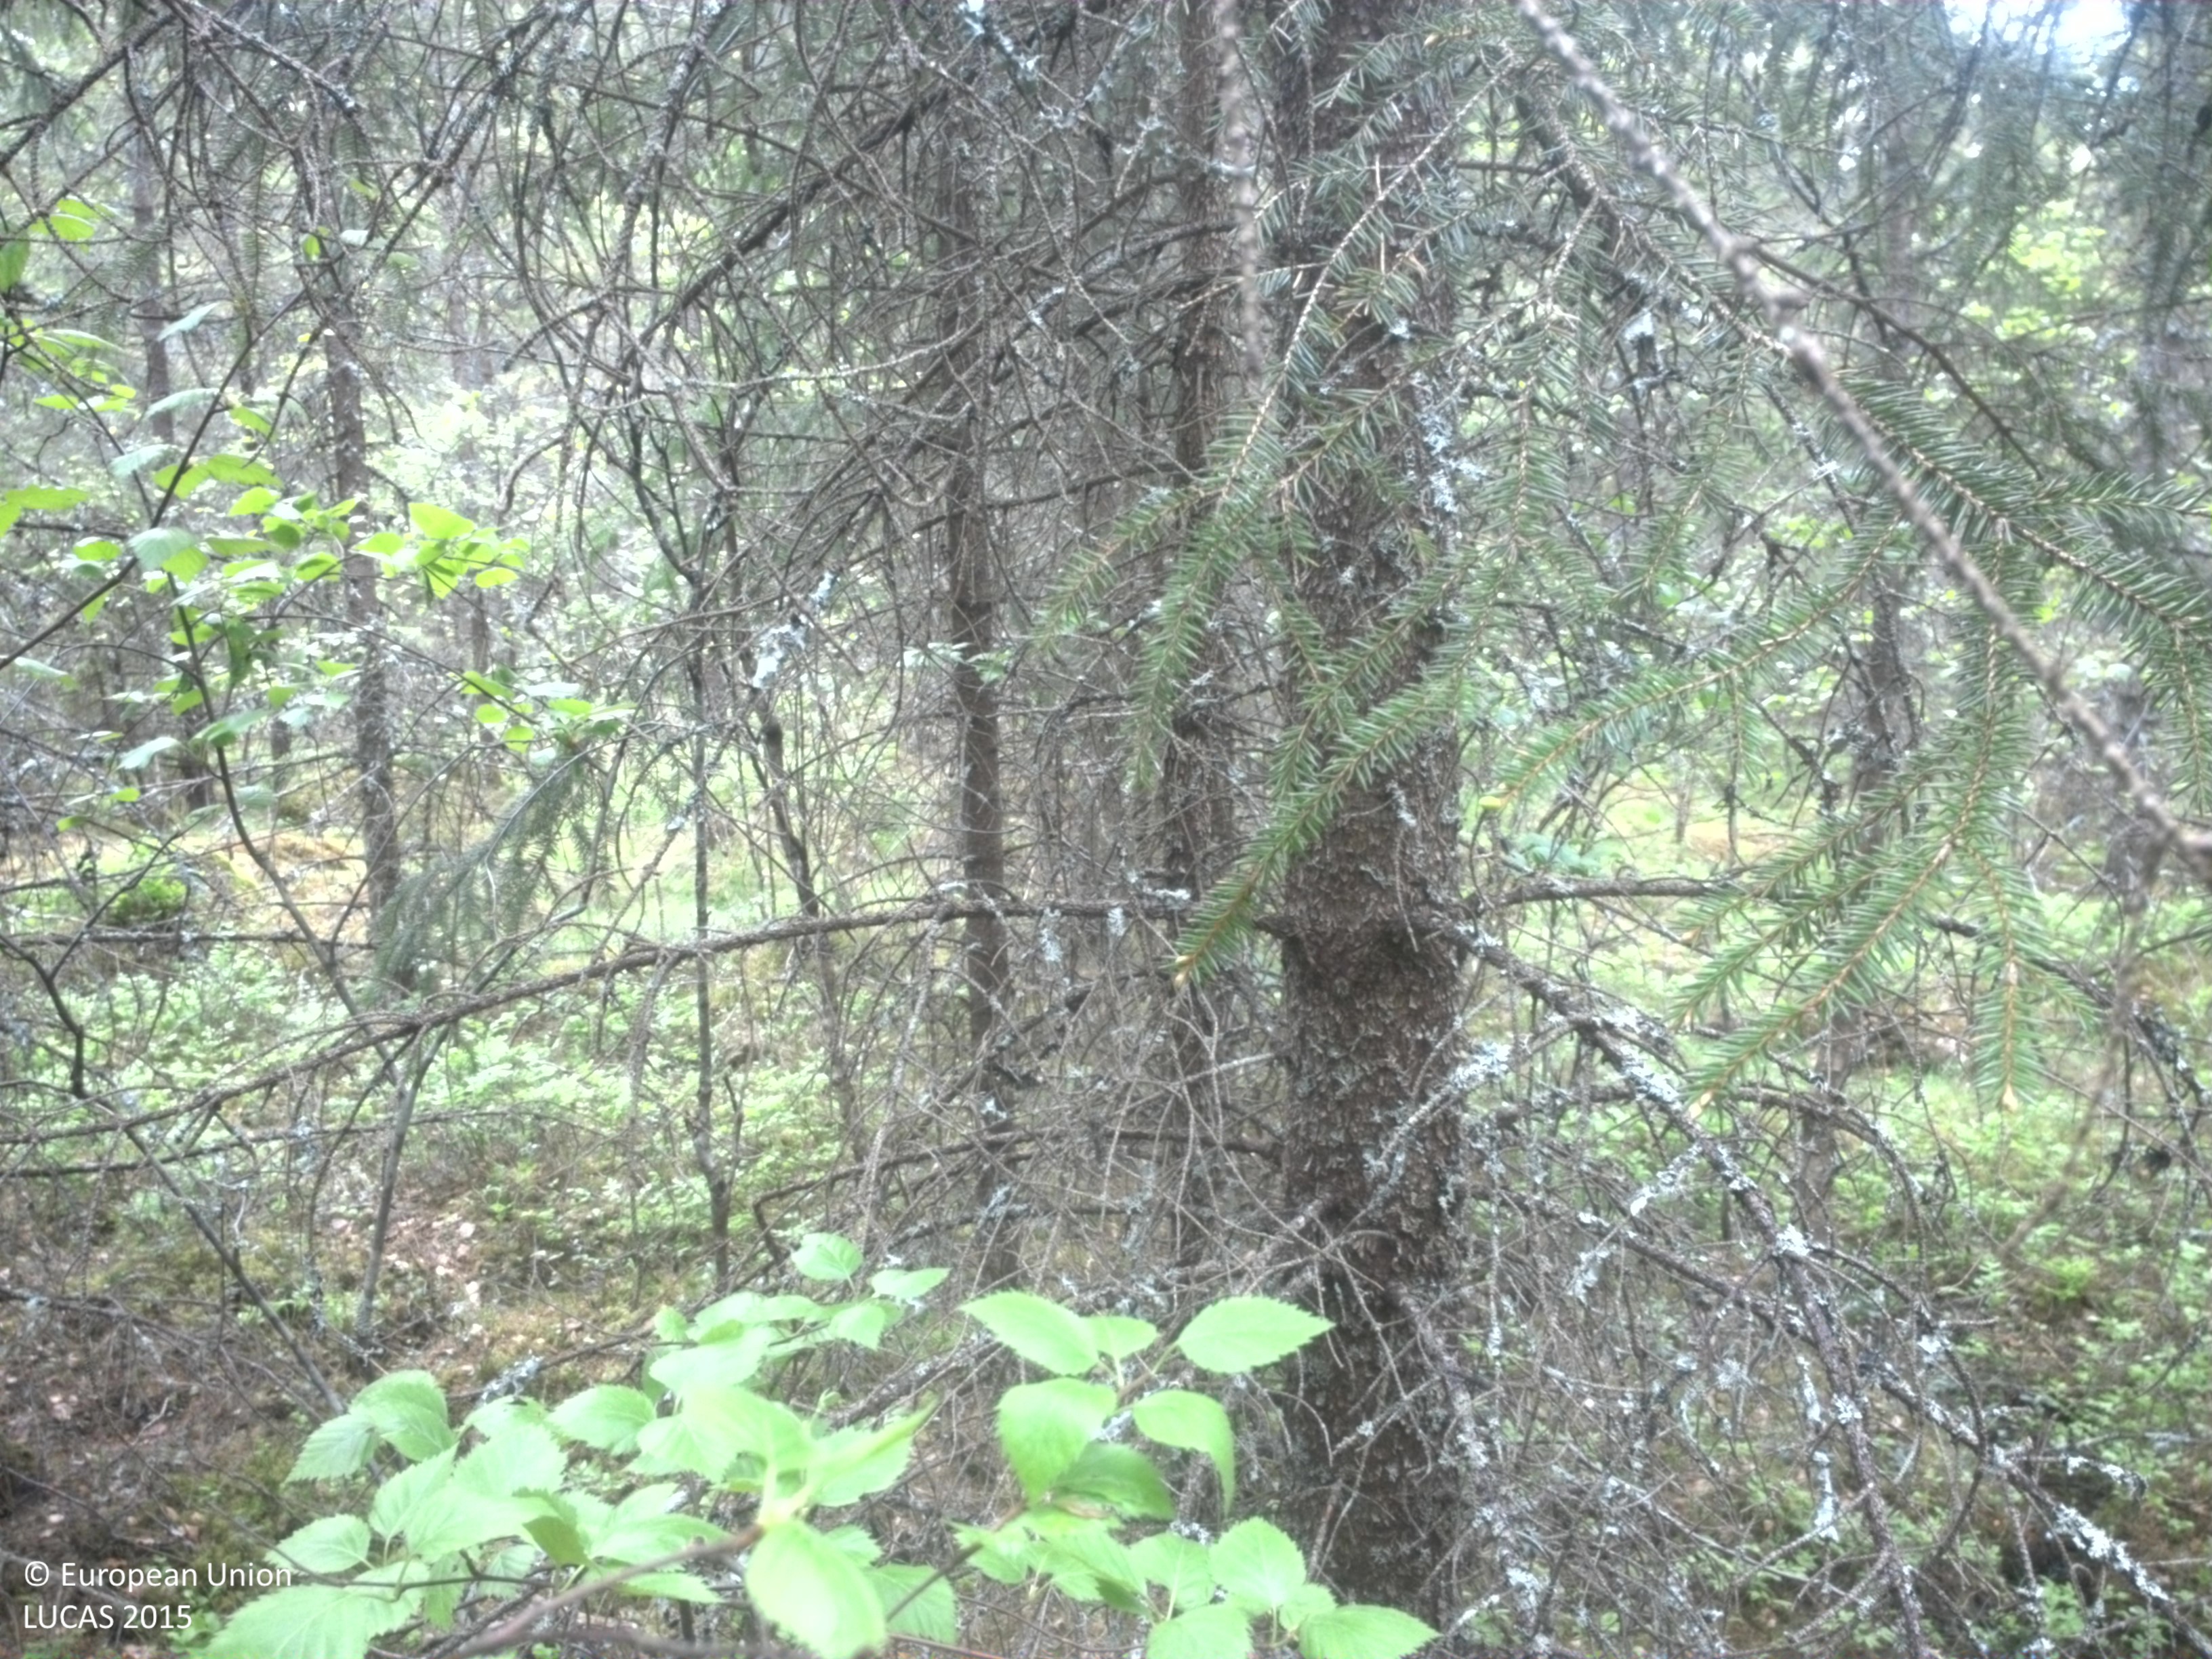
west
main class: Woodland
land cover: Spruce dominated coniferous woodland
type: boreal forest
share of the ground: > 75 %
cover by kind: coniferous forest trees 65 %, broadleaved forest trees 10 %, shrubs 10 %, lichens and mosses 10 %, herbaceous plants 5 %
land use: Forestry
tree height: > 5 m
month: June
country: SE
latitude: 59.5260
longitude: 14.1101
